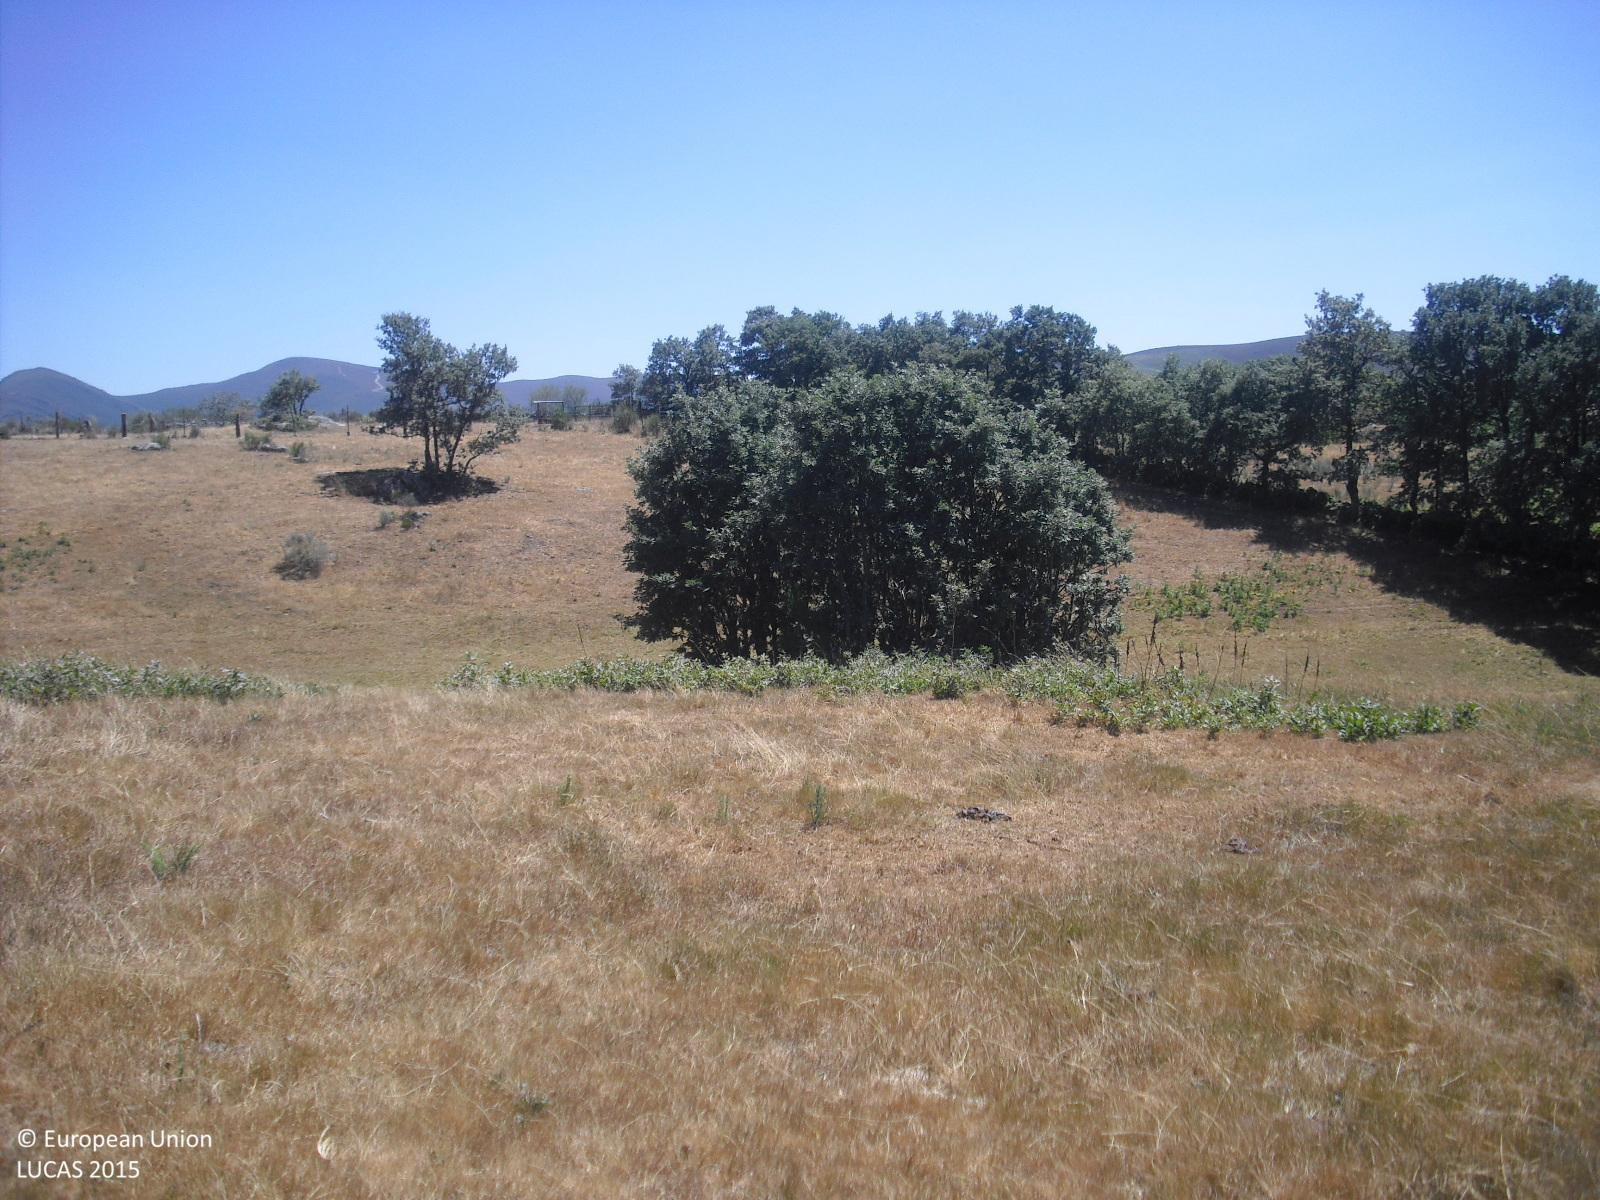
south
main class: Grassland
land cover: Grassland with sparse tree/shrub cover
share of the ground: > 75 %
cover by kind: herbaceous plants 90 %, broadleaved forest trees 5 %, shrubs 5 %
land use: Agriculture (excluding fallow land and kitchen gardens)
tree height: > 5 m
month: July
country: ES
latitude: 42.2703
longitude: -7.4385
